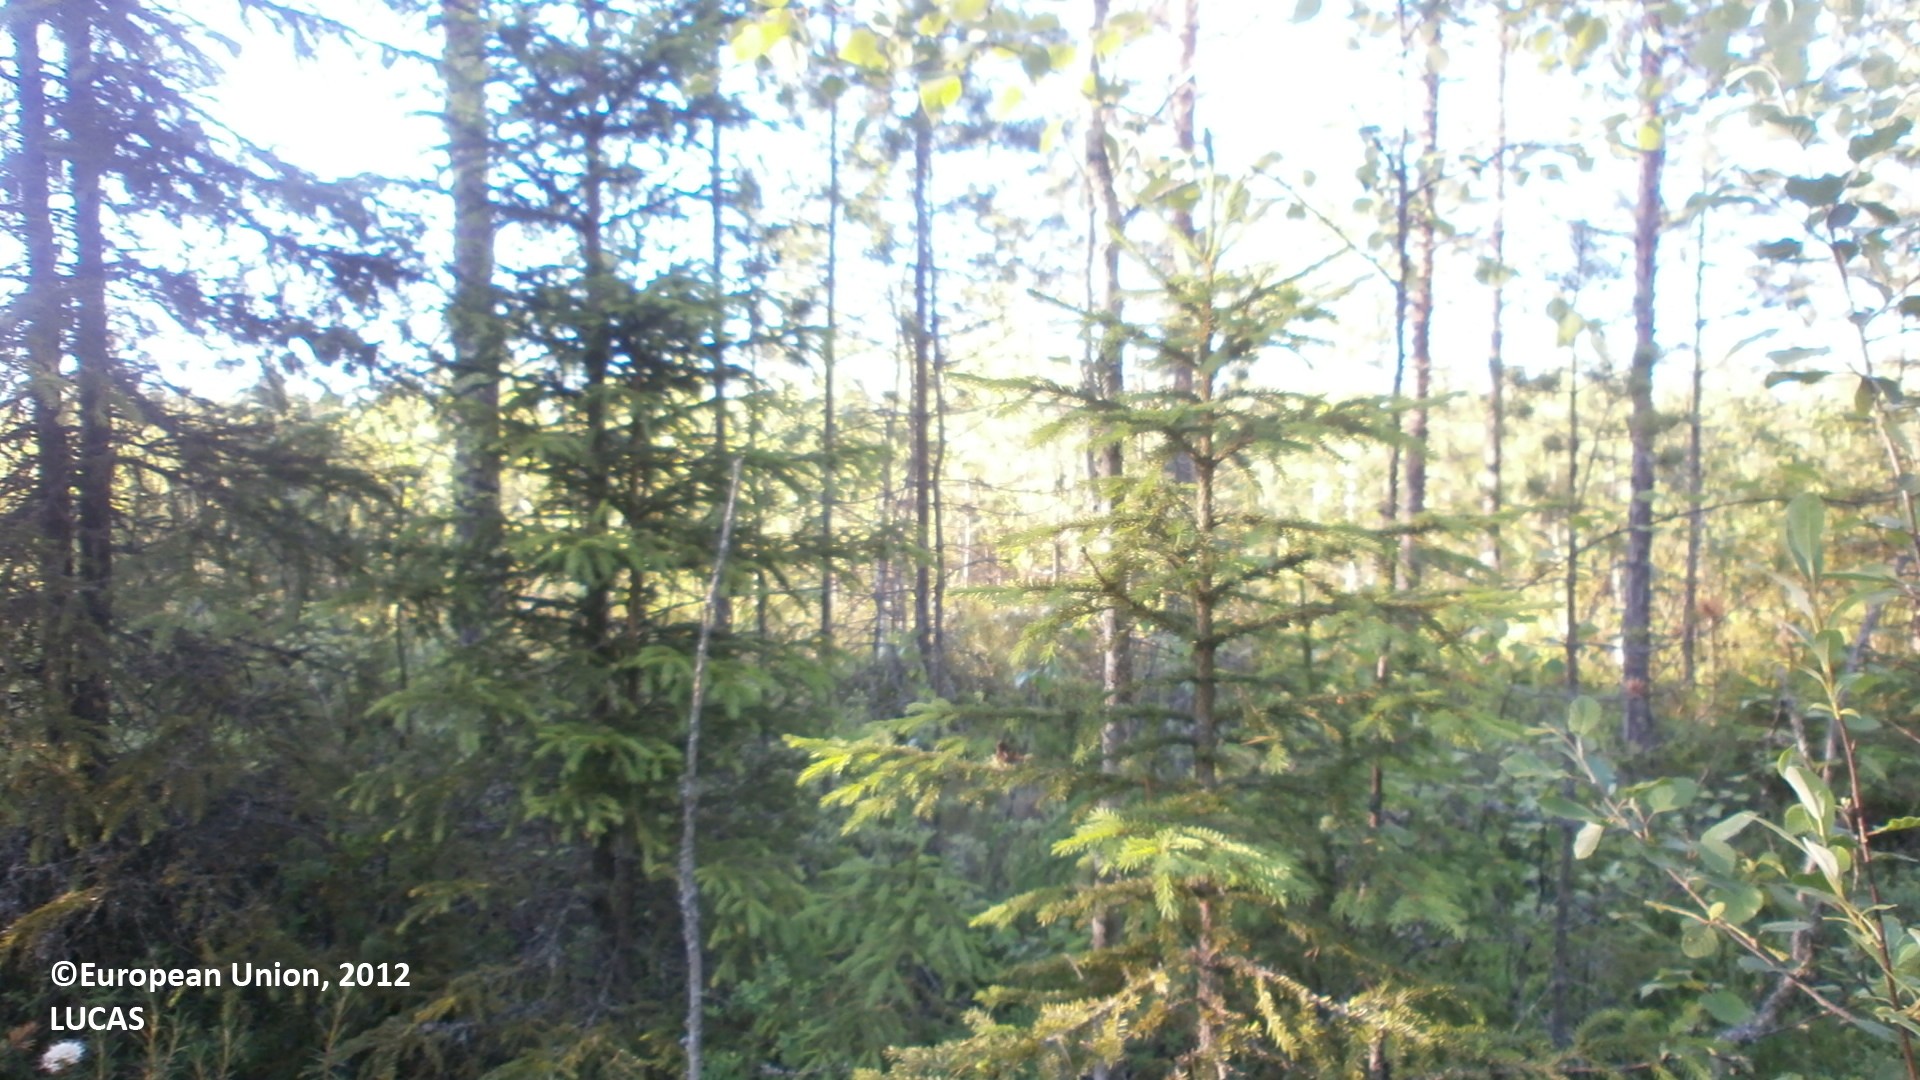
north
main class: Woodland
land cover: Pine dominated coniferous woodland
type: boreal forest
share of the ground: 50 - 75 %
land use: Forestry
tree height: > 5 m
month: July
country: FI
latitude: 64.2380
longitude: 24.9490
